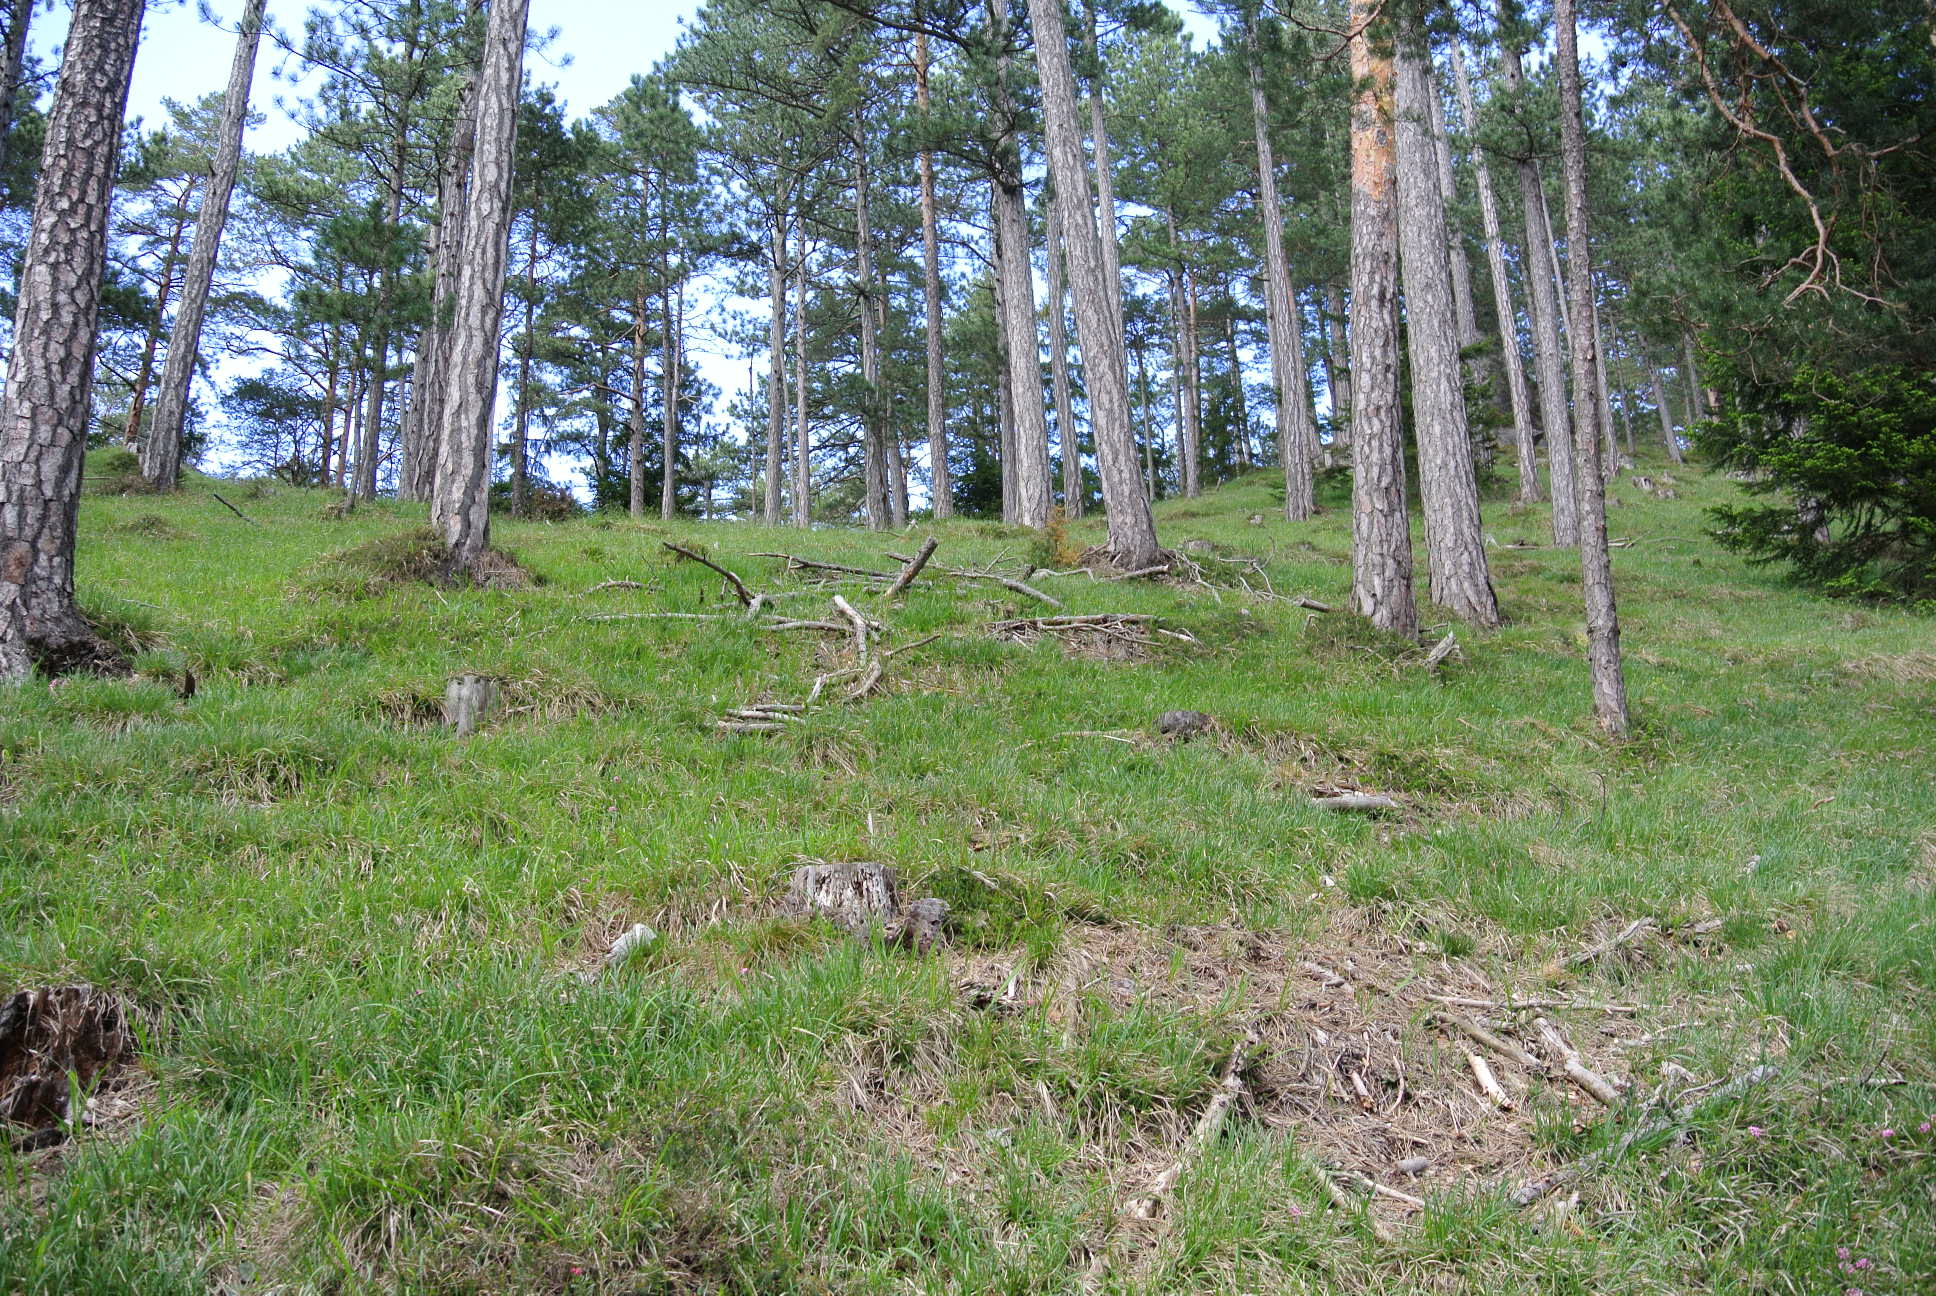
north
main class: Woodland
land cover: Pine dominated mixed woodland
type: alpine coniferous forest
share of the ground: > 75 %
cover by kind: coniferous forest trees 70 %, broadleaved forest trees 25 %, herbaceous plants 5 %
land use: Forestry
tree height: > 5 m
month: May
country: AT
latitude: 47.9152
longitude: 16.0111
